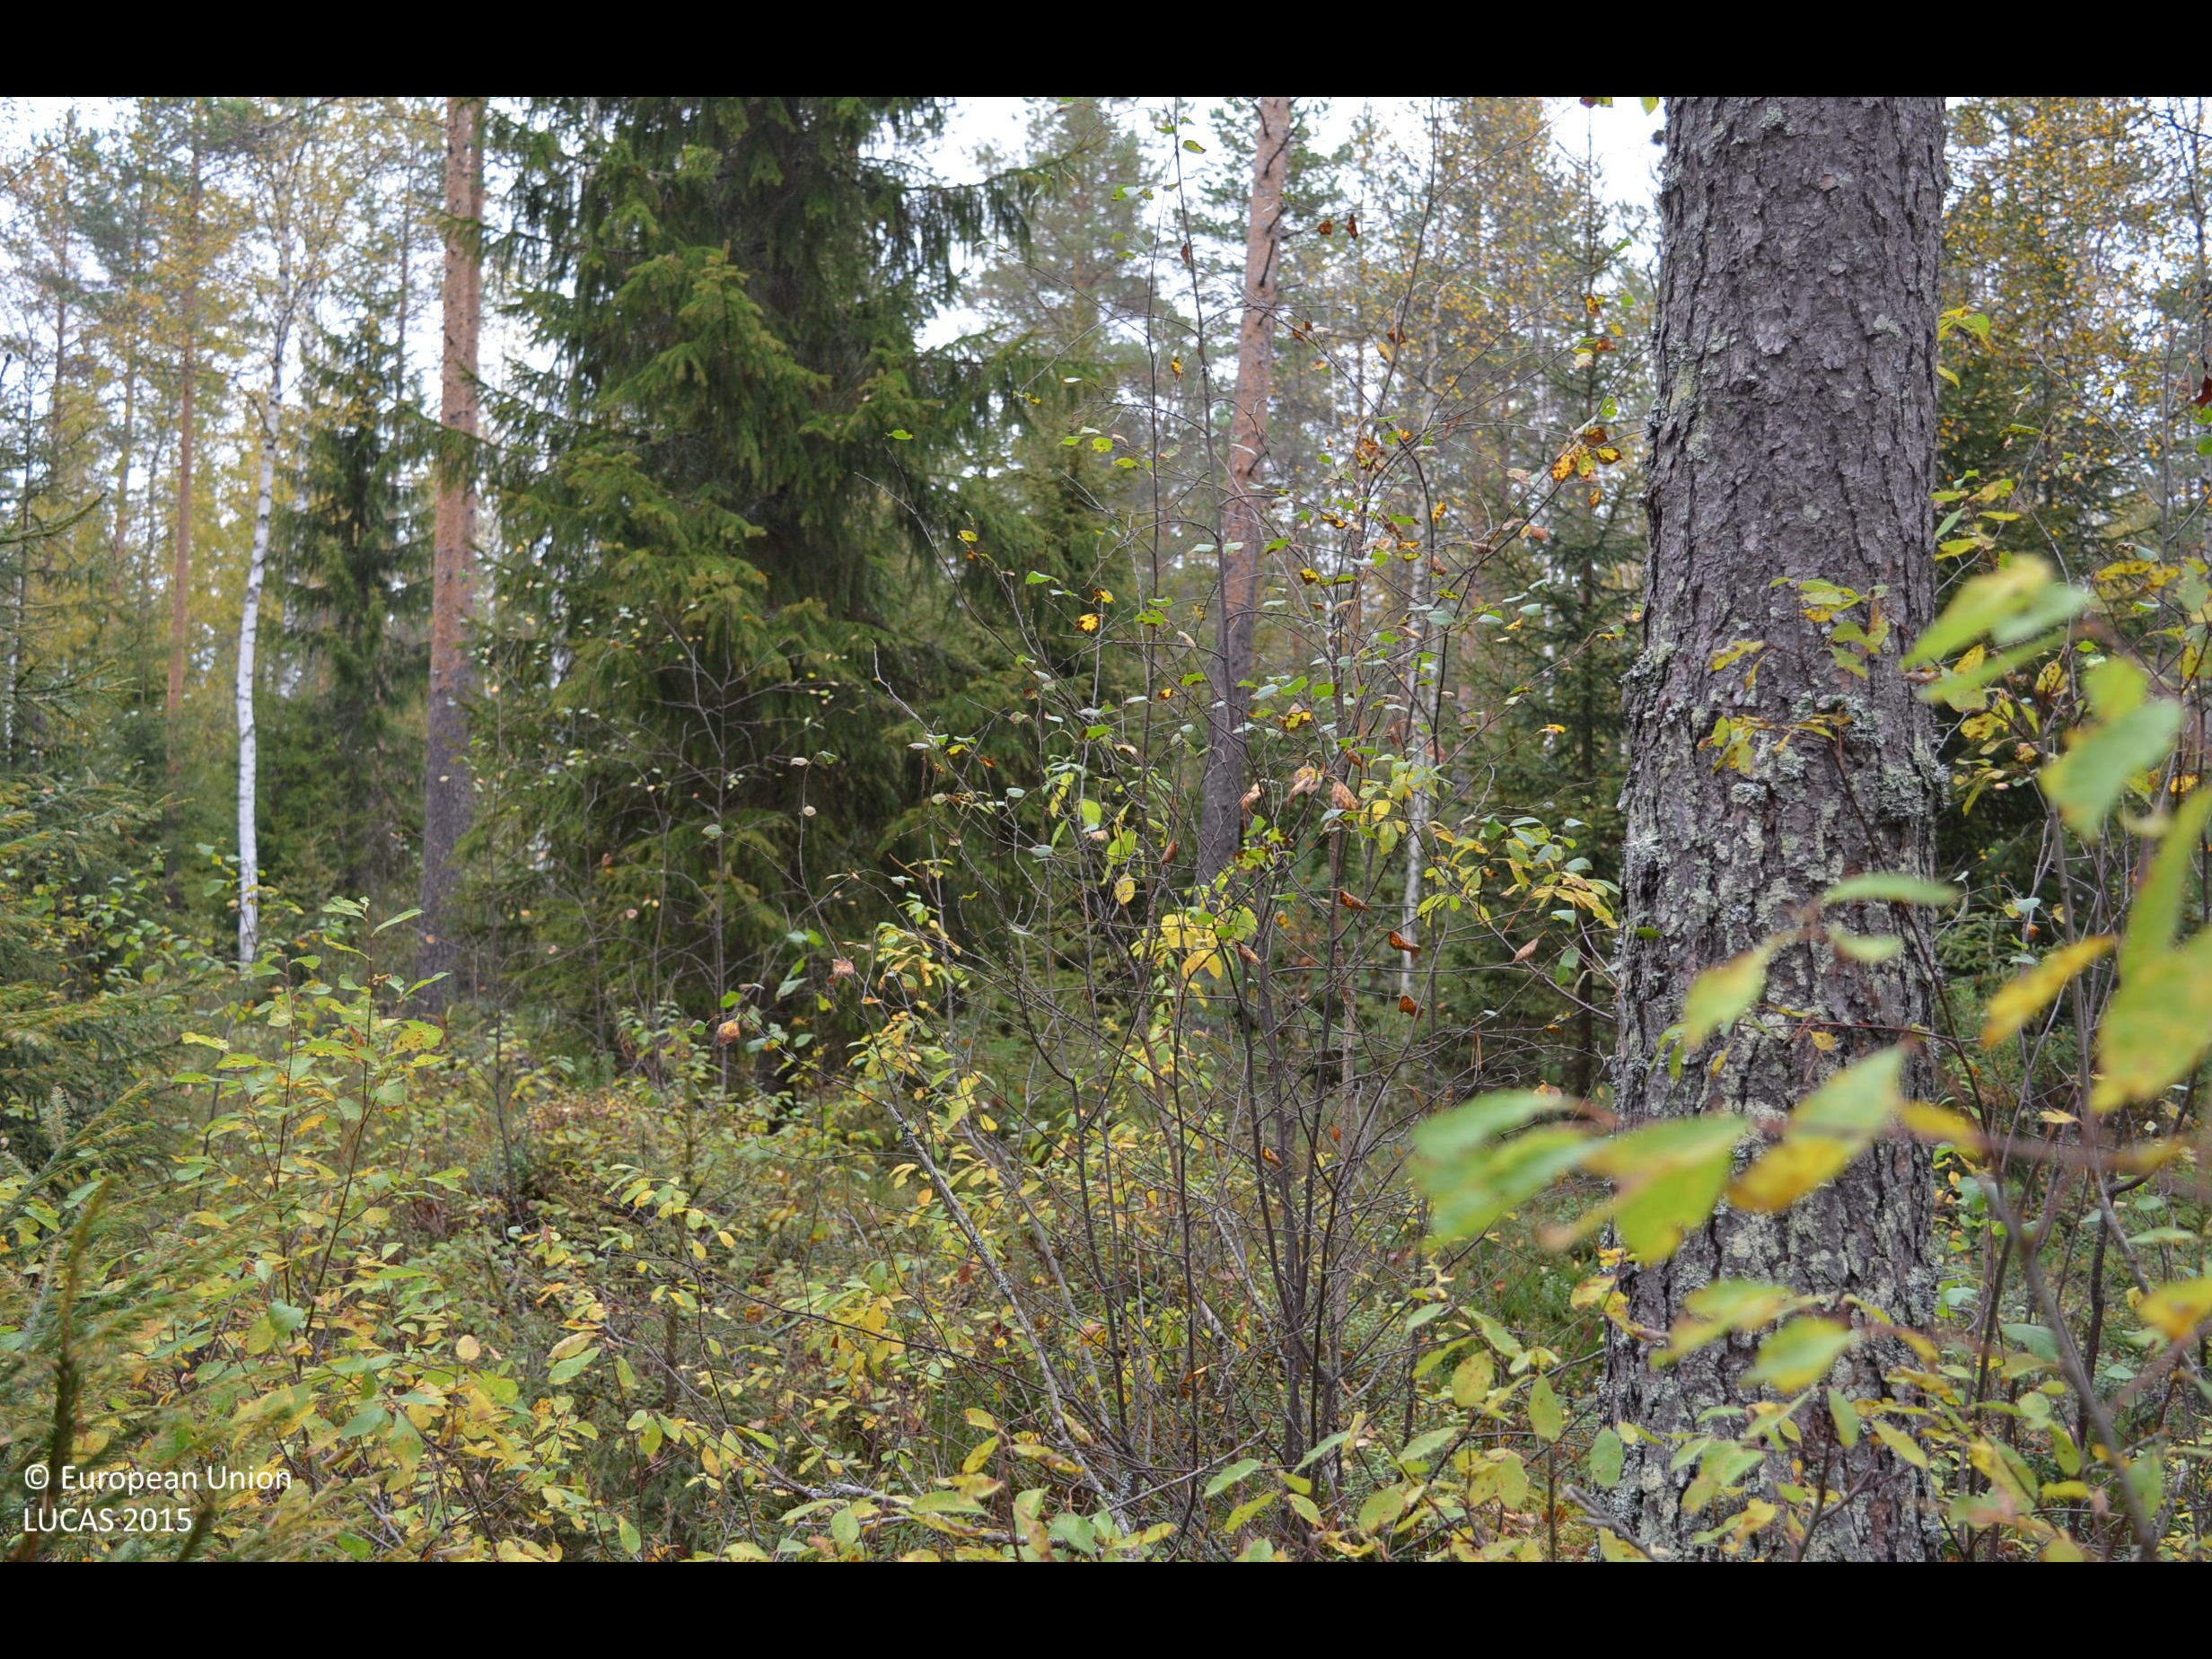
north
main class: Woodland
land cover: Pine dominated mixed woodland
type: boreal forest
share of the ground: 50 - 75 %
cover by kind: coniferous forest trees 40 %, shrubs 35 %, broadleaved forest trees 25 %
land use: Forestry
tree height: > 5 m
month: September
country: FI
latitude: 62.7621
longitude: 23.8028
